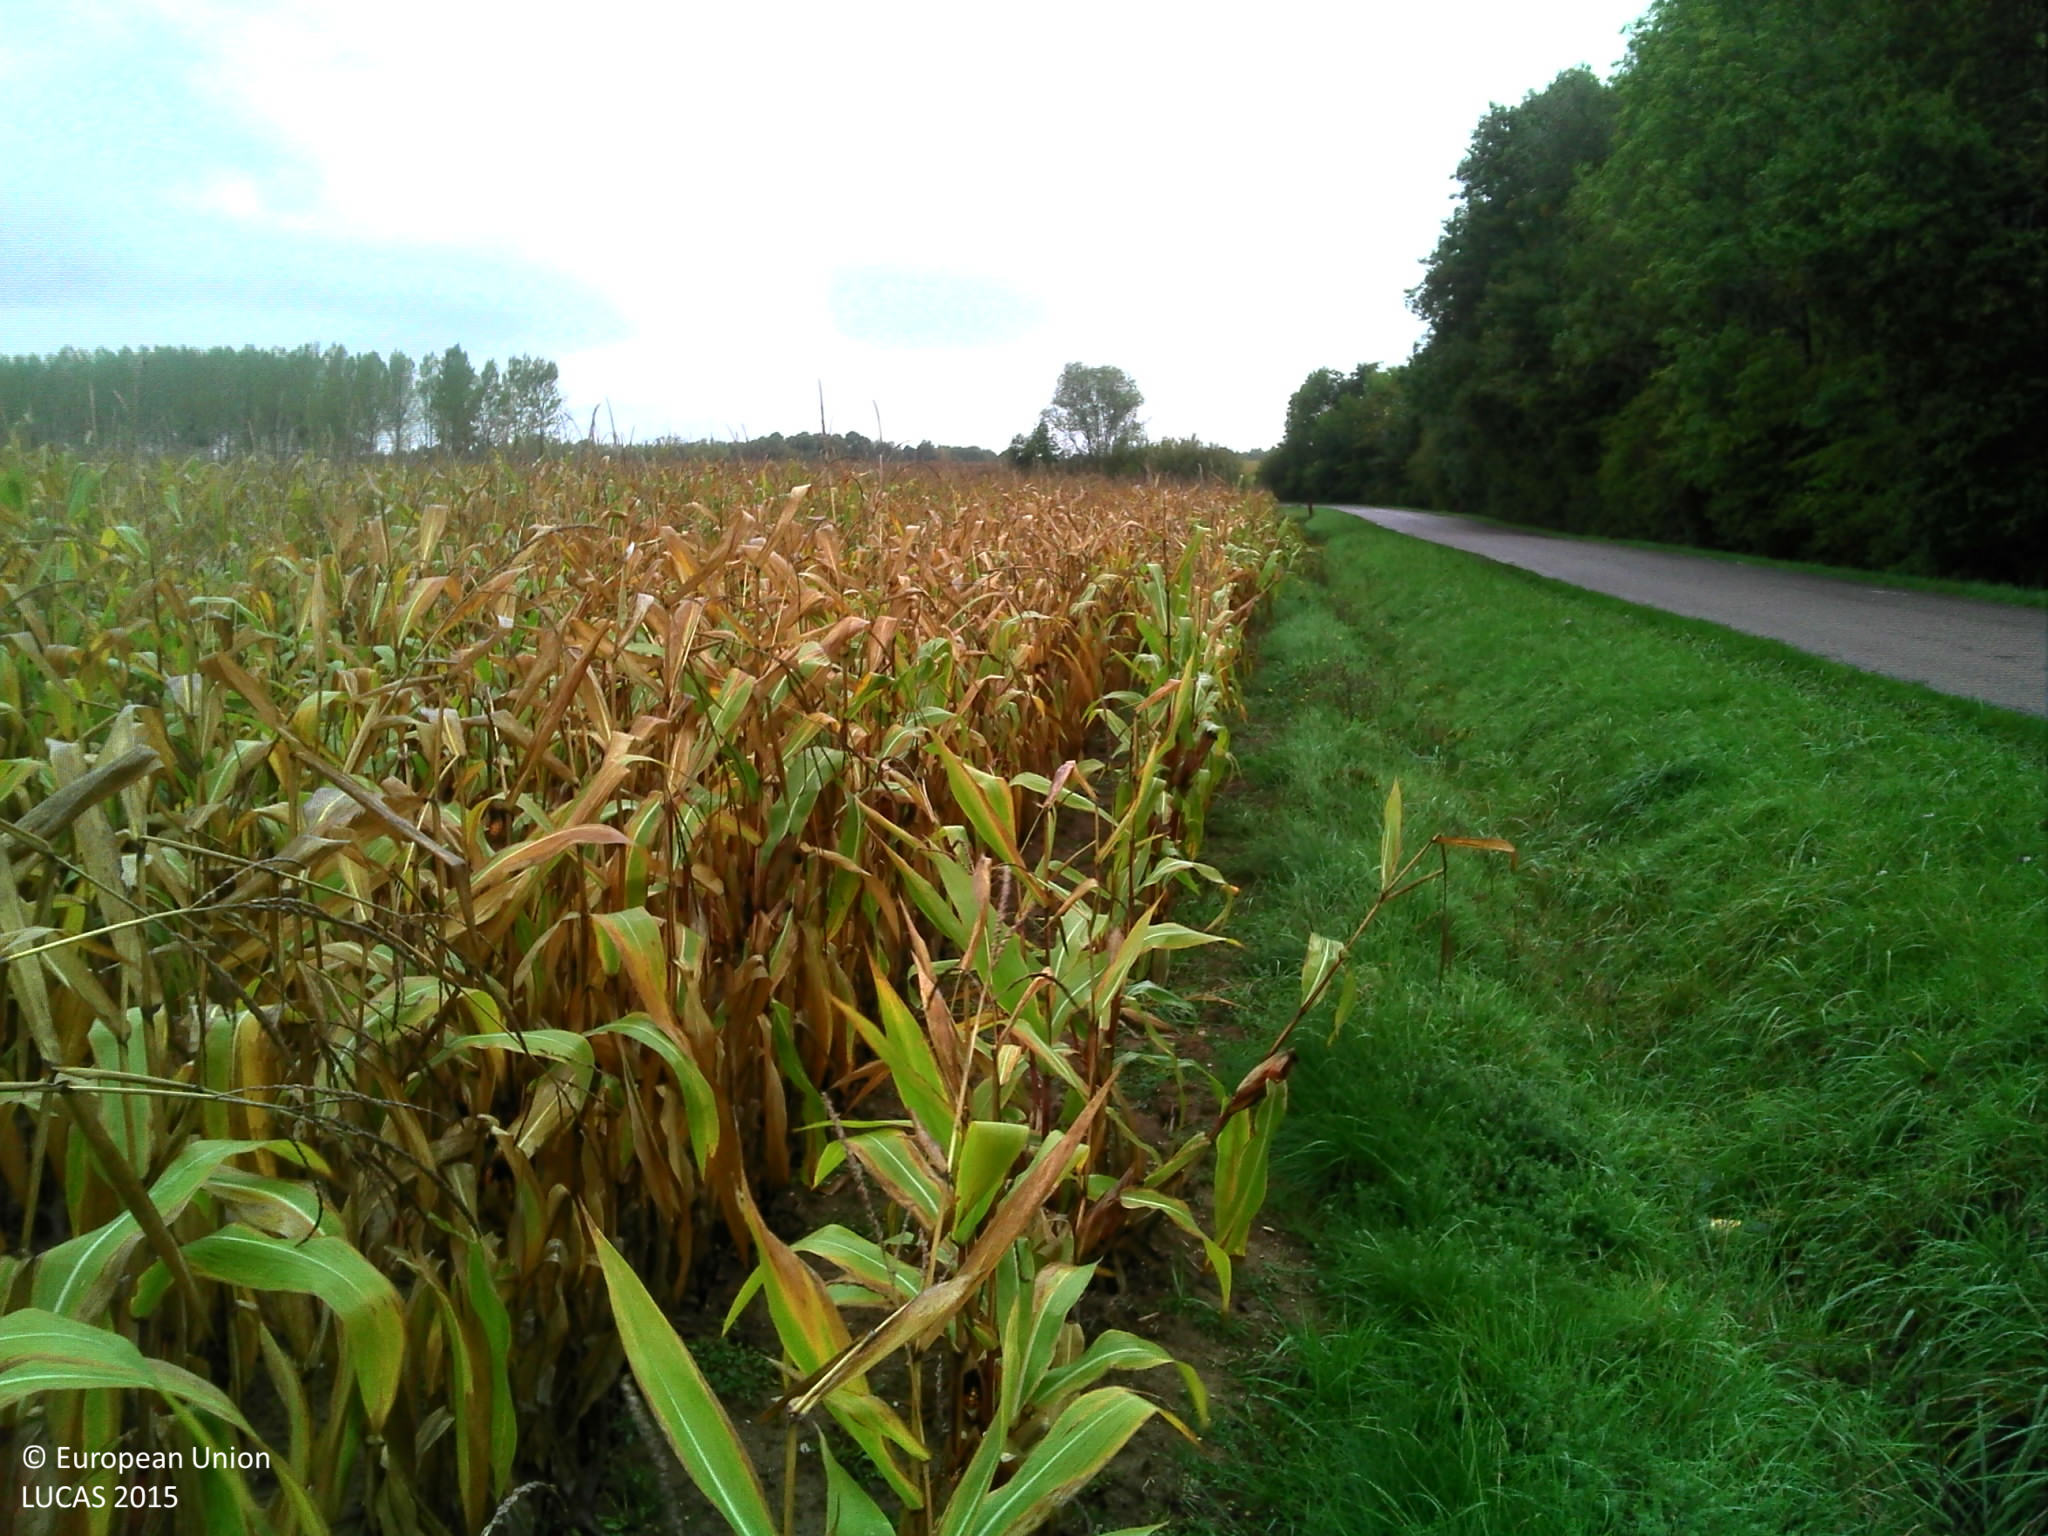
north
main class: Cropland
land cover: Maize
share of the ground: > 75 %
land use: Agriculture (excluding fallow land and kitchen gardens)
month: October
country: FR
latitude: 48.2329
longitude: 4.1942
